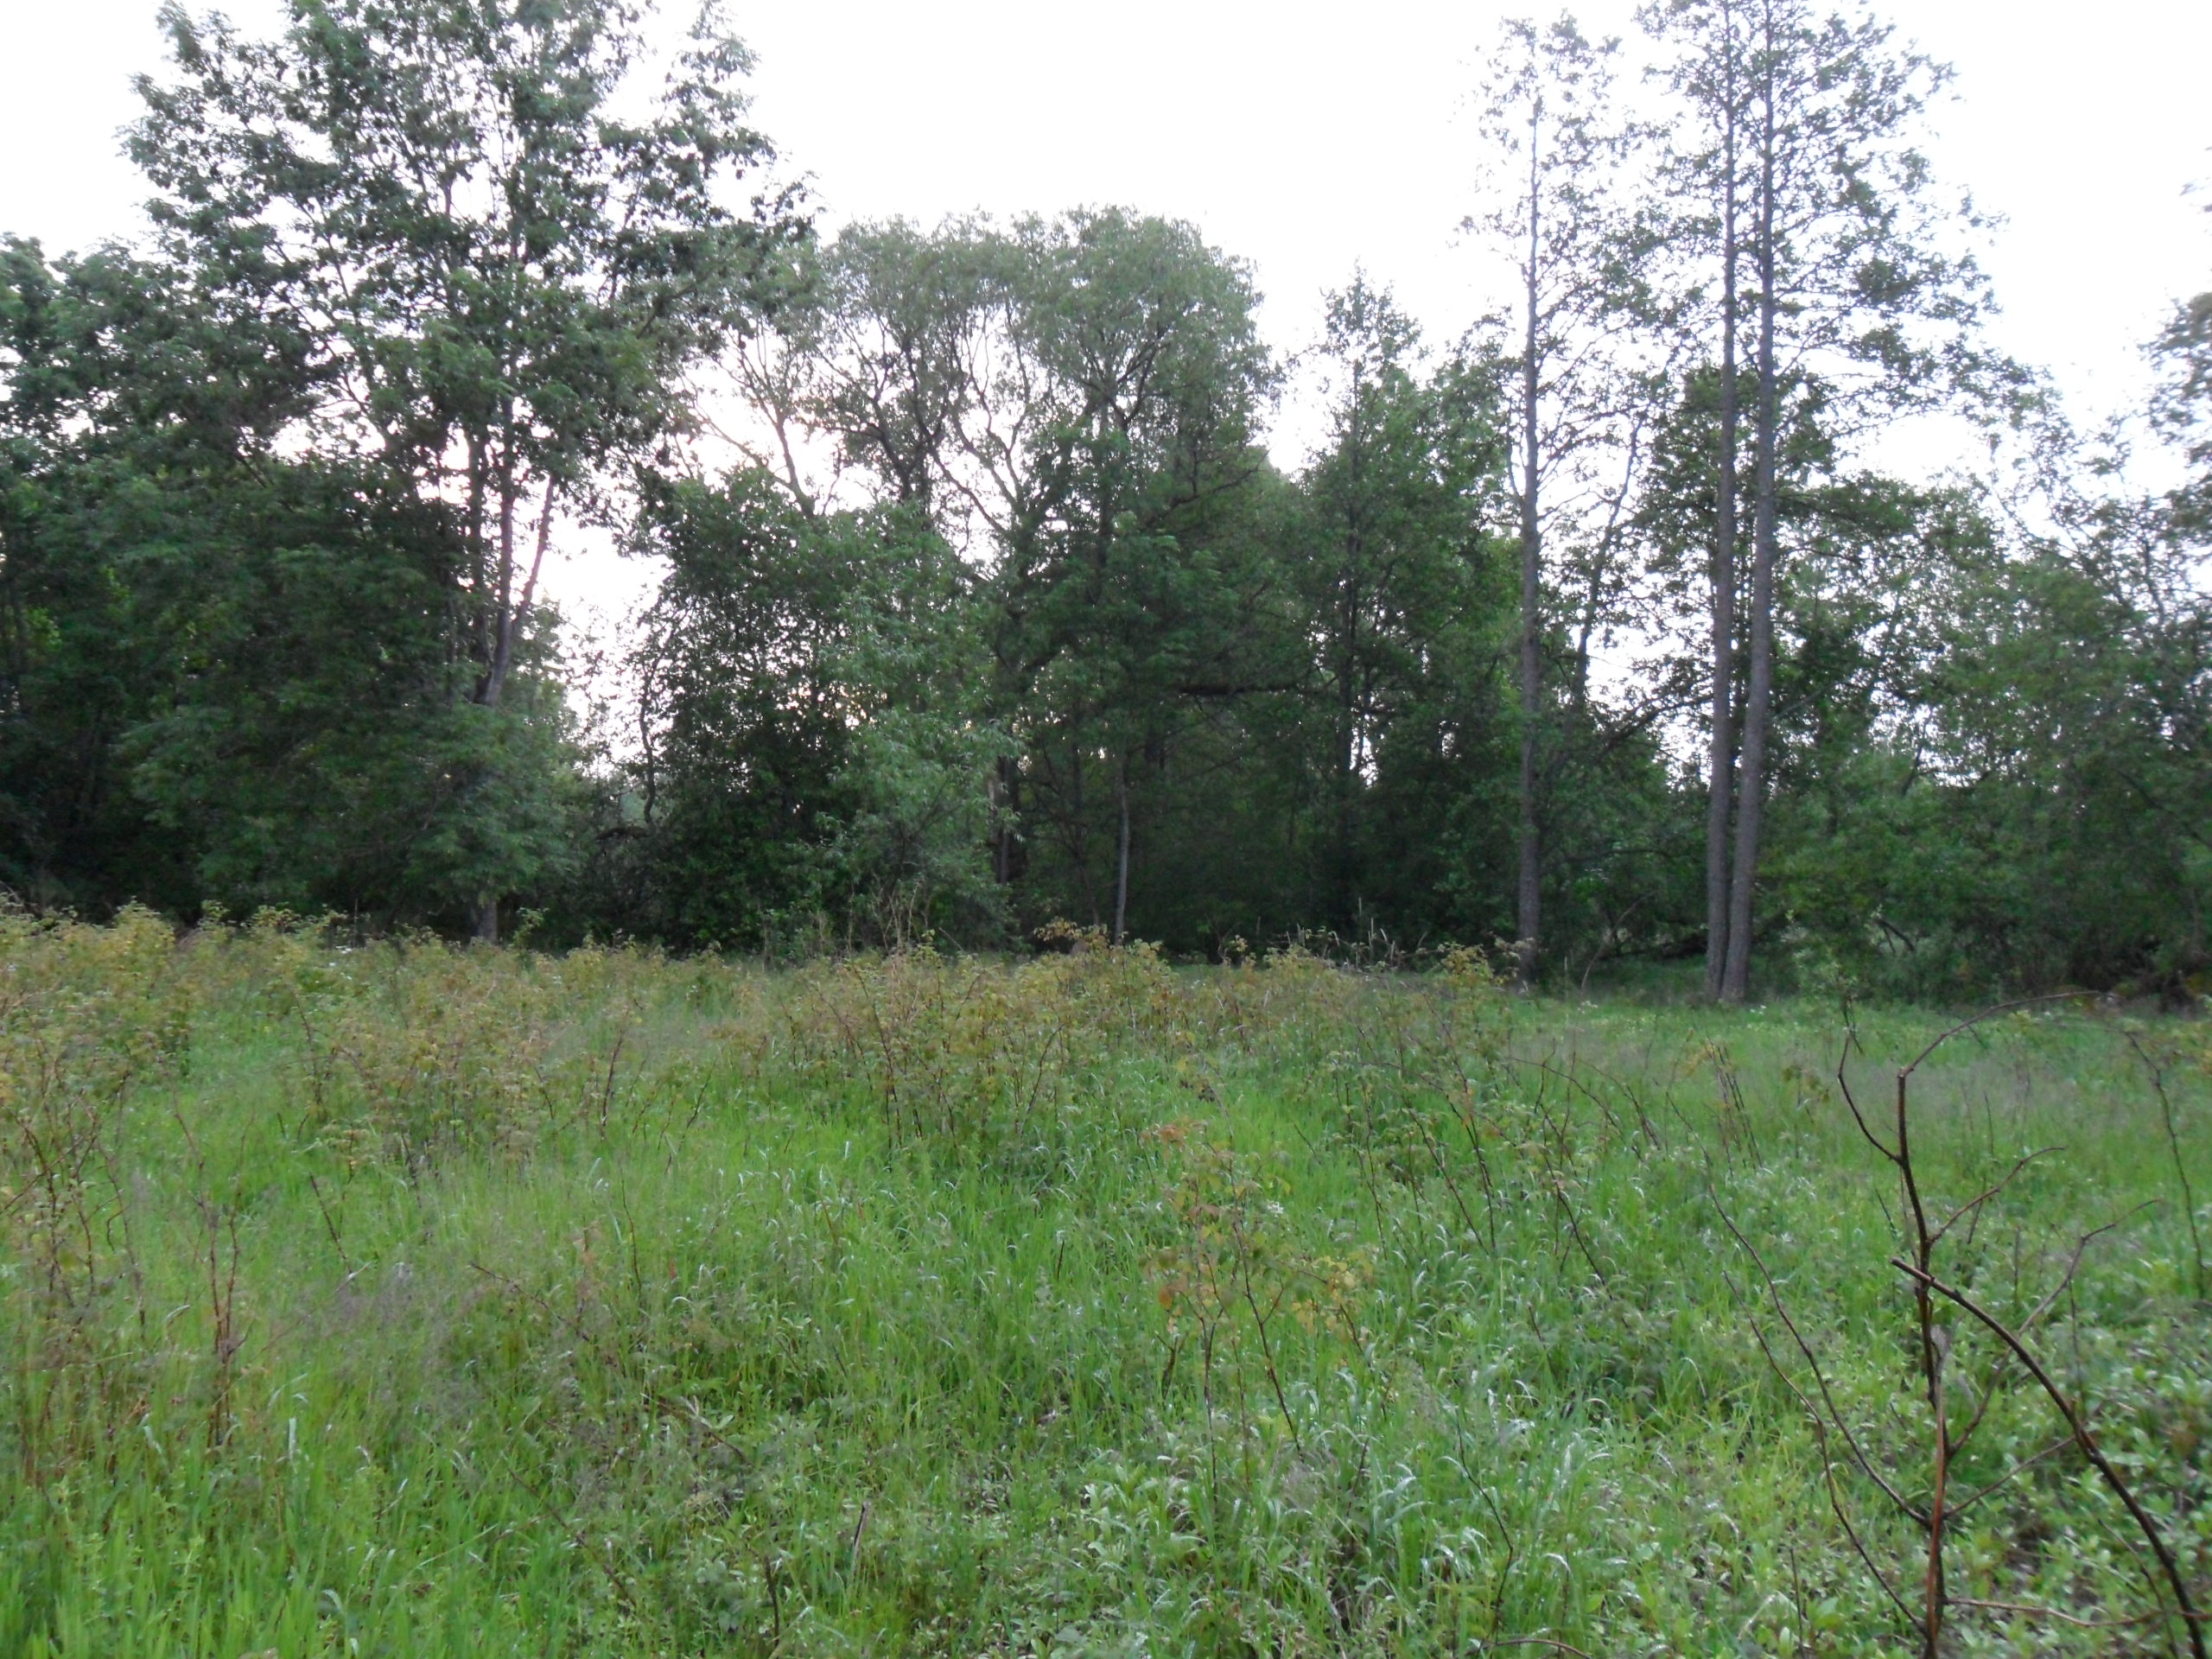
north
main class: Shrubland
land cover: Shrubland with sparse tree cover
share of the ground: > 75 %
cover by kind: shrubs 90 %, broadleaved forest trees 5 %, herbaceous plants 5 %
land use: Semi-natural and natural areas not in use
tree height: < 5 m
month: June
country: LV
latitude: 57.5026
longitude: 21.9430
